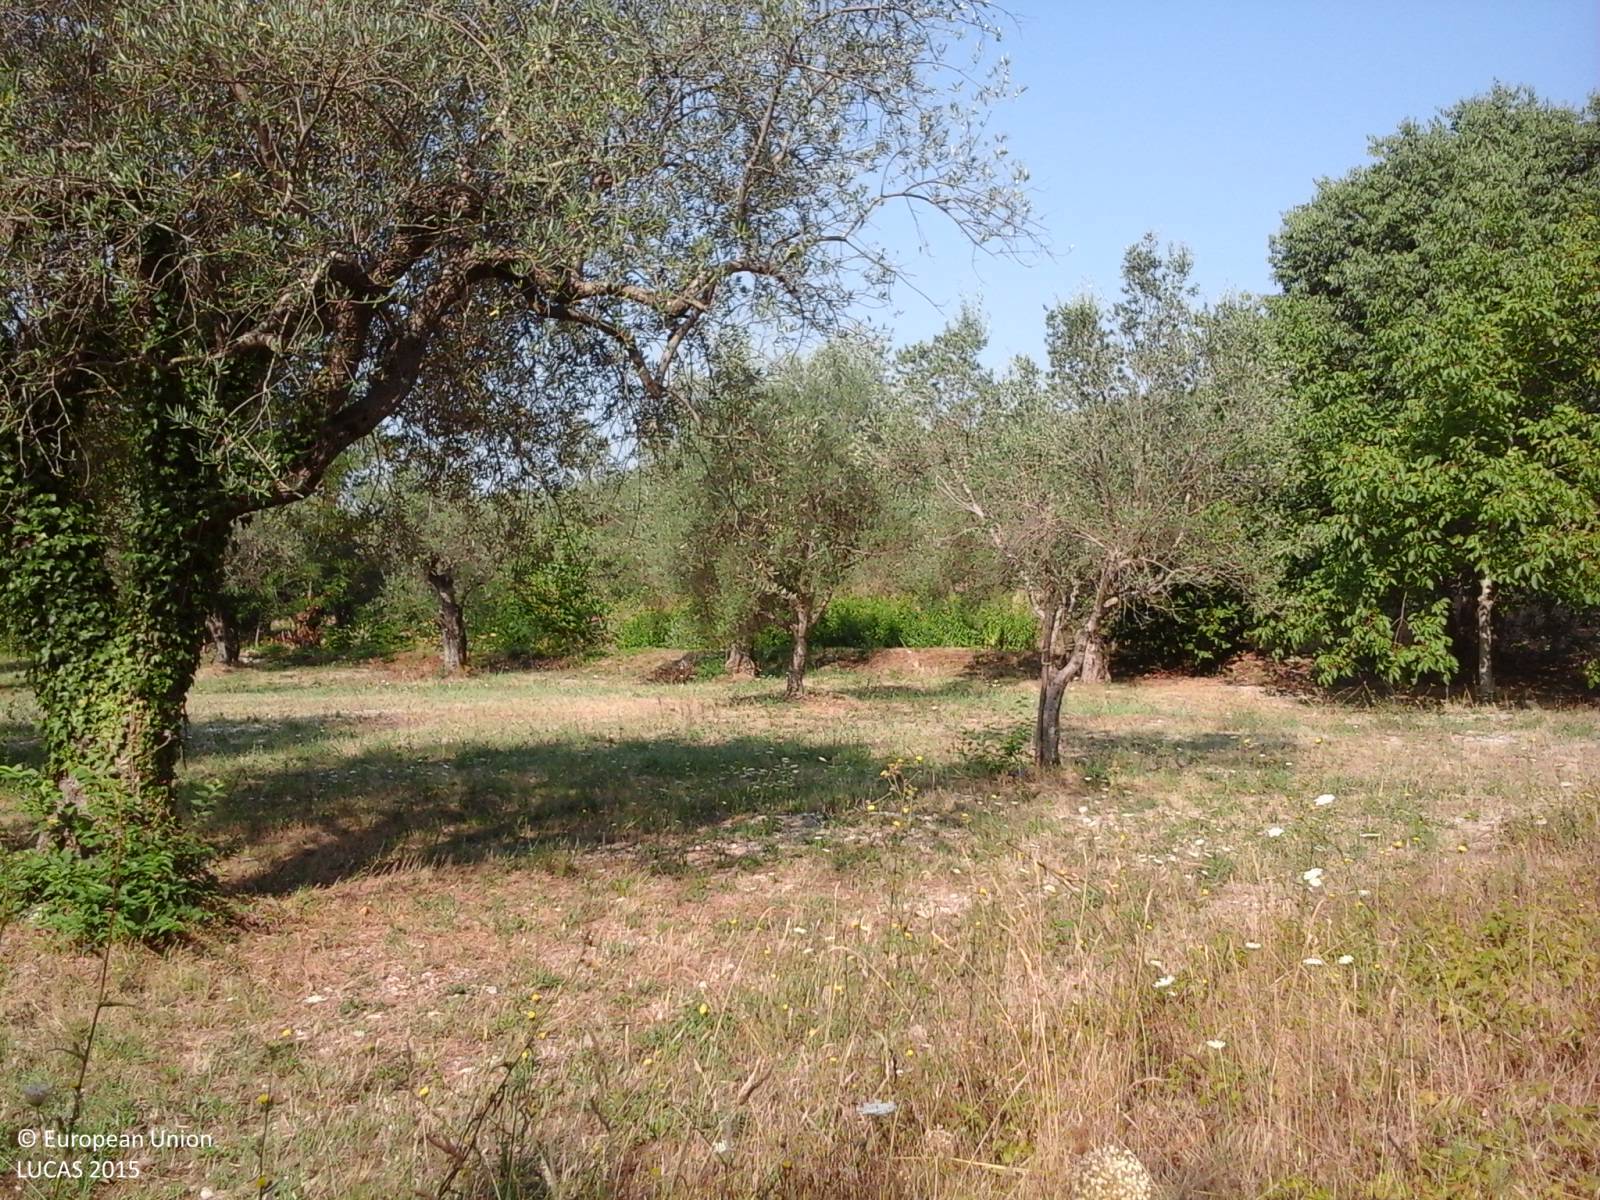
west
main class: Cropland
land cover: Olive groves
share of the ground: 50 - 75 %
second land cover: Spontaneously vegetated surfaces
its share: > 75 %
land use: Agriculture (excluding fallow land and kitchen gardens)
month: August
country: IT
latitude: 41.3516
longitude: 14.2747
